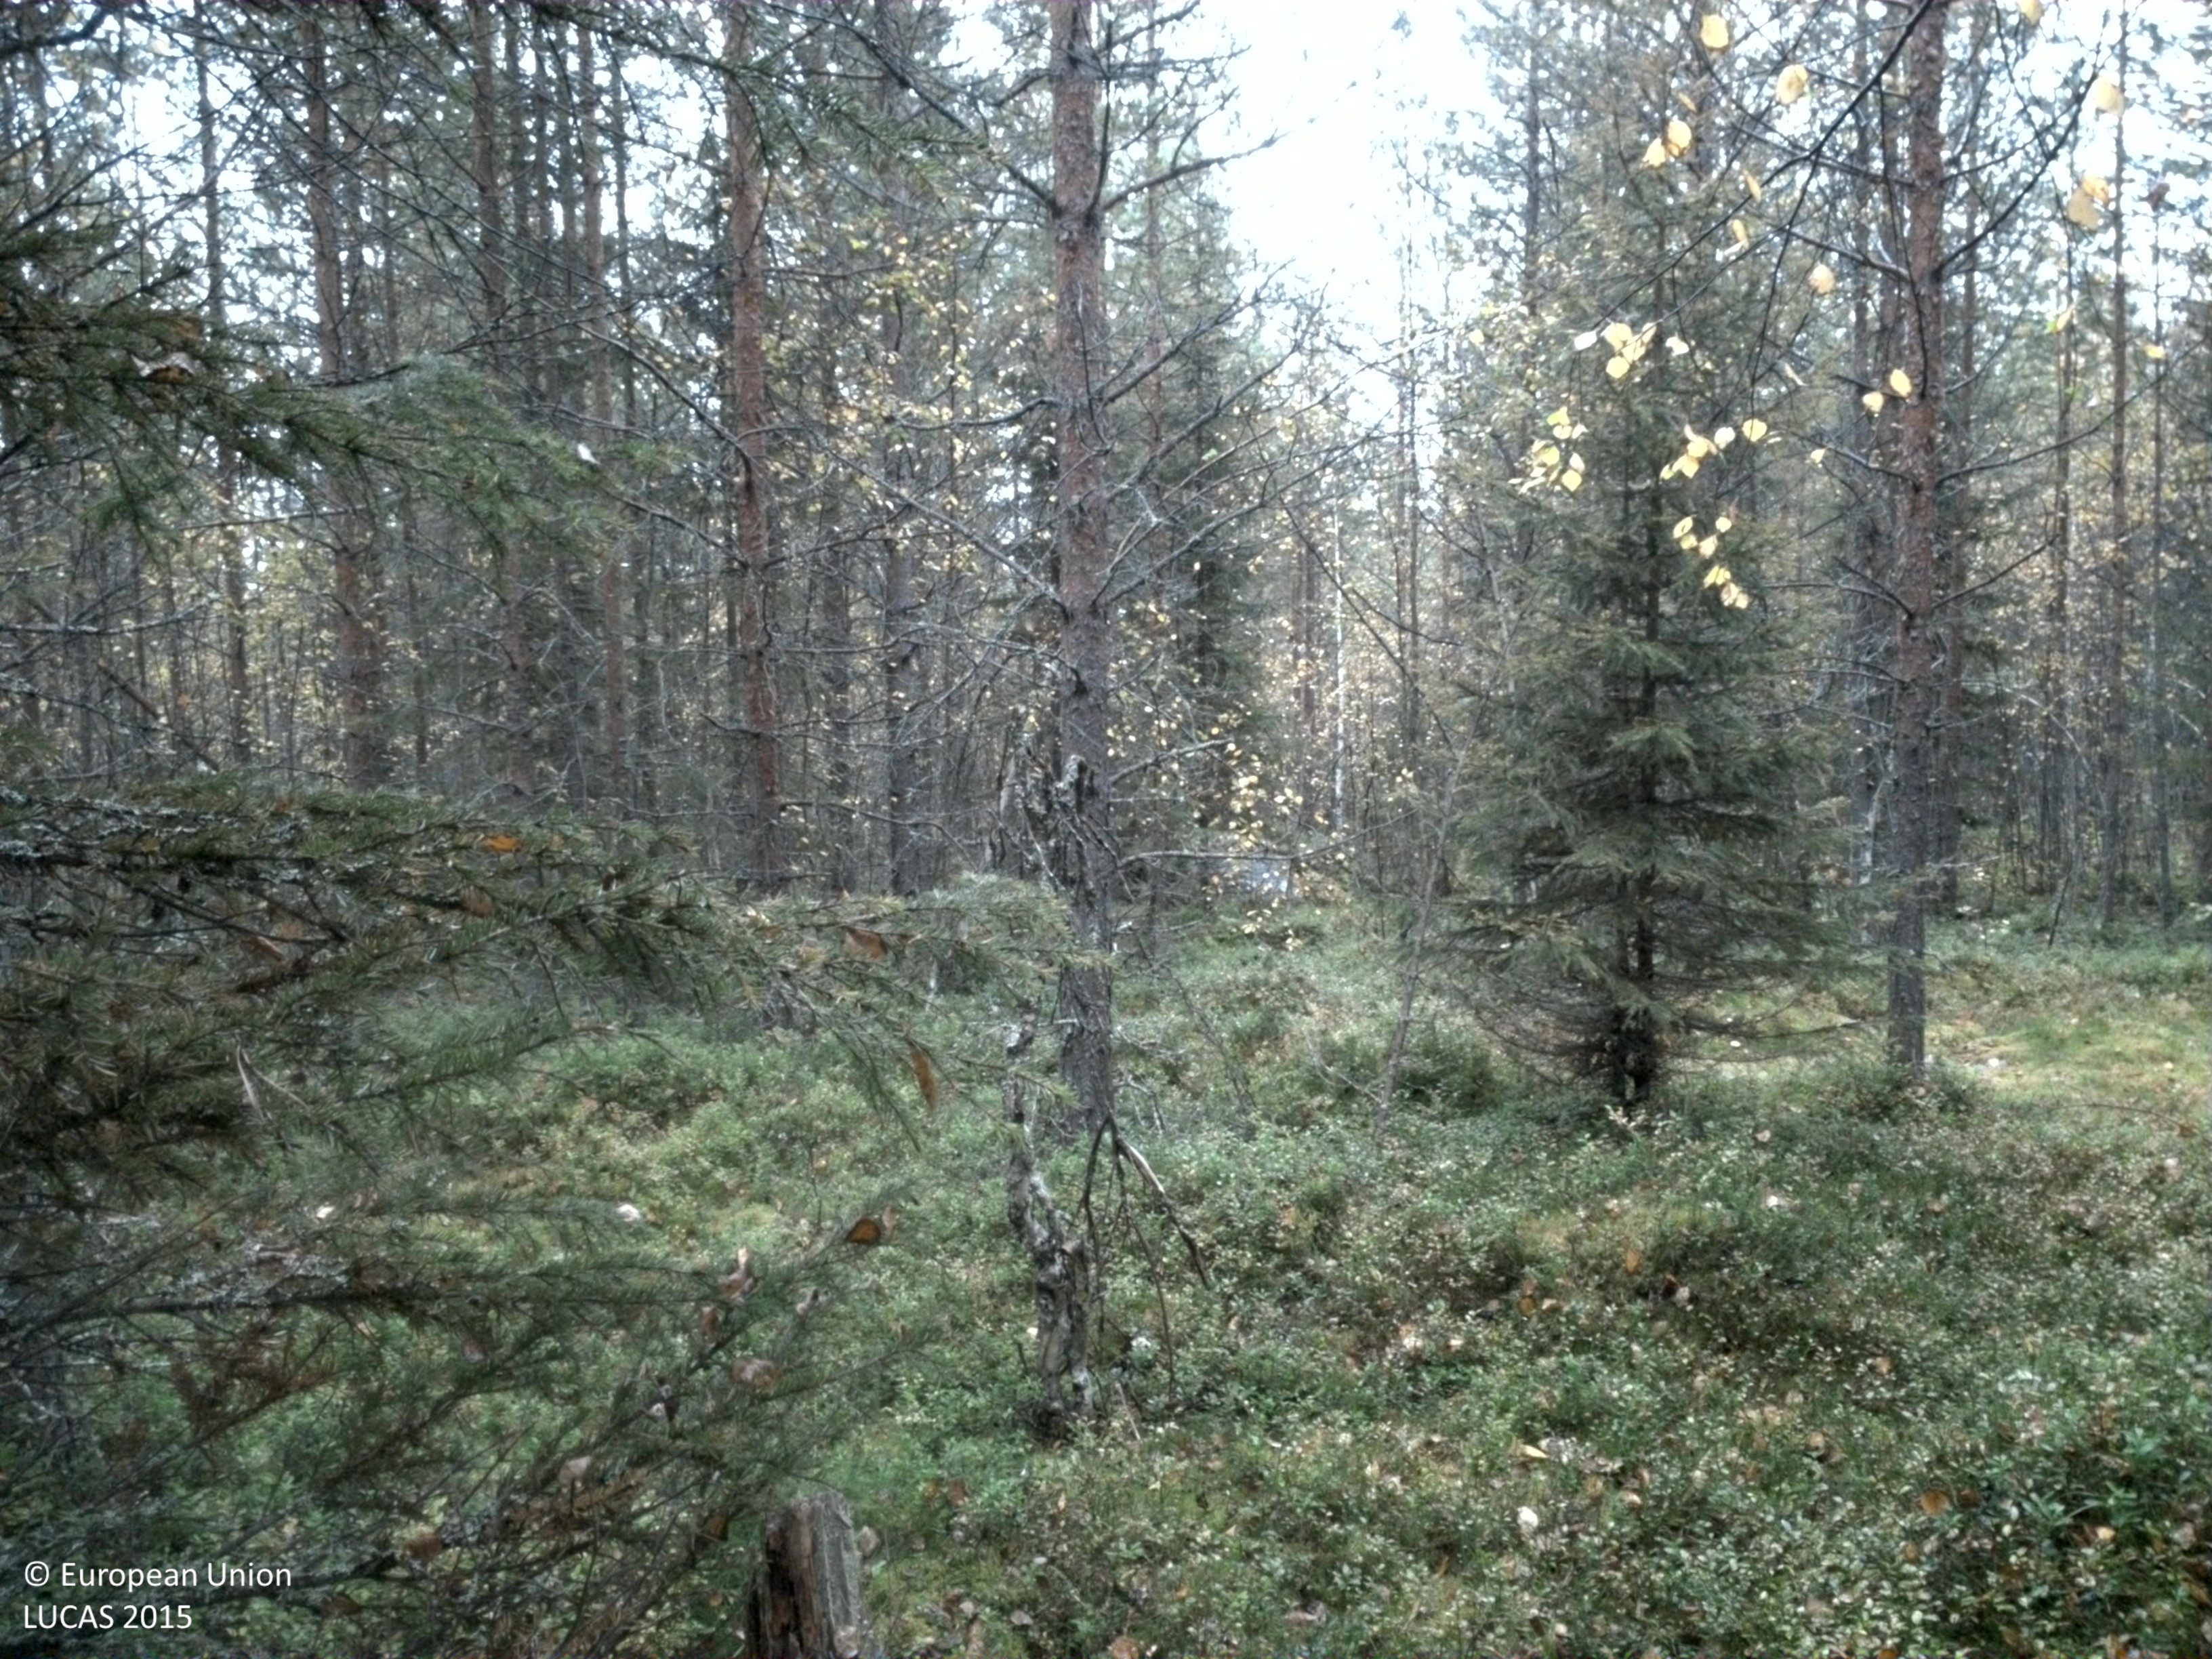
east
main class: Woodland
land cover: Pine dominated coniferous woodland
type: boreal forest
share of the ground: 25 - 50 %
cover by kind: shrubs 50 %, coniferous forest trees 35 %, broadleaved forest trees 10 %, lichens and mosses 5 %
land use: Forestry
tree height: > 5 m
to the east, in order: Pine dominated coniferous woodland; Spruce dominated coniferous woodland; Ditches and canals; Spruce dominated coniferous woodland; Pine dominated coniferous woodland; Spruce dominated coniferous woodland
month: September
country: SE
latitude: 65.7990
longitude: 22.1539
